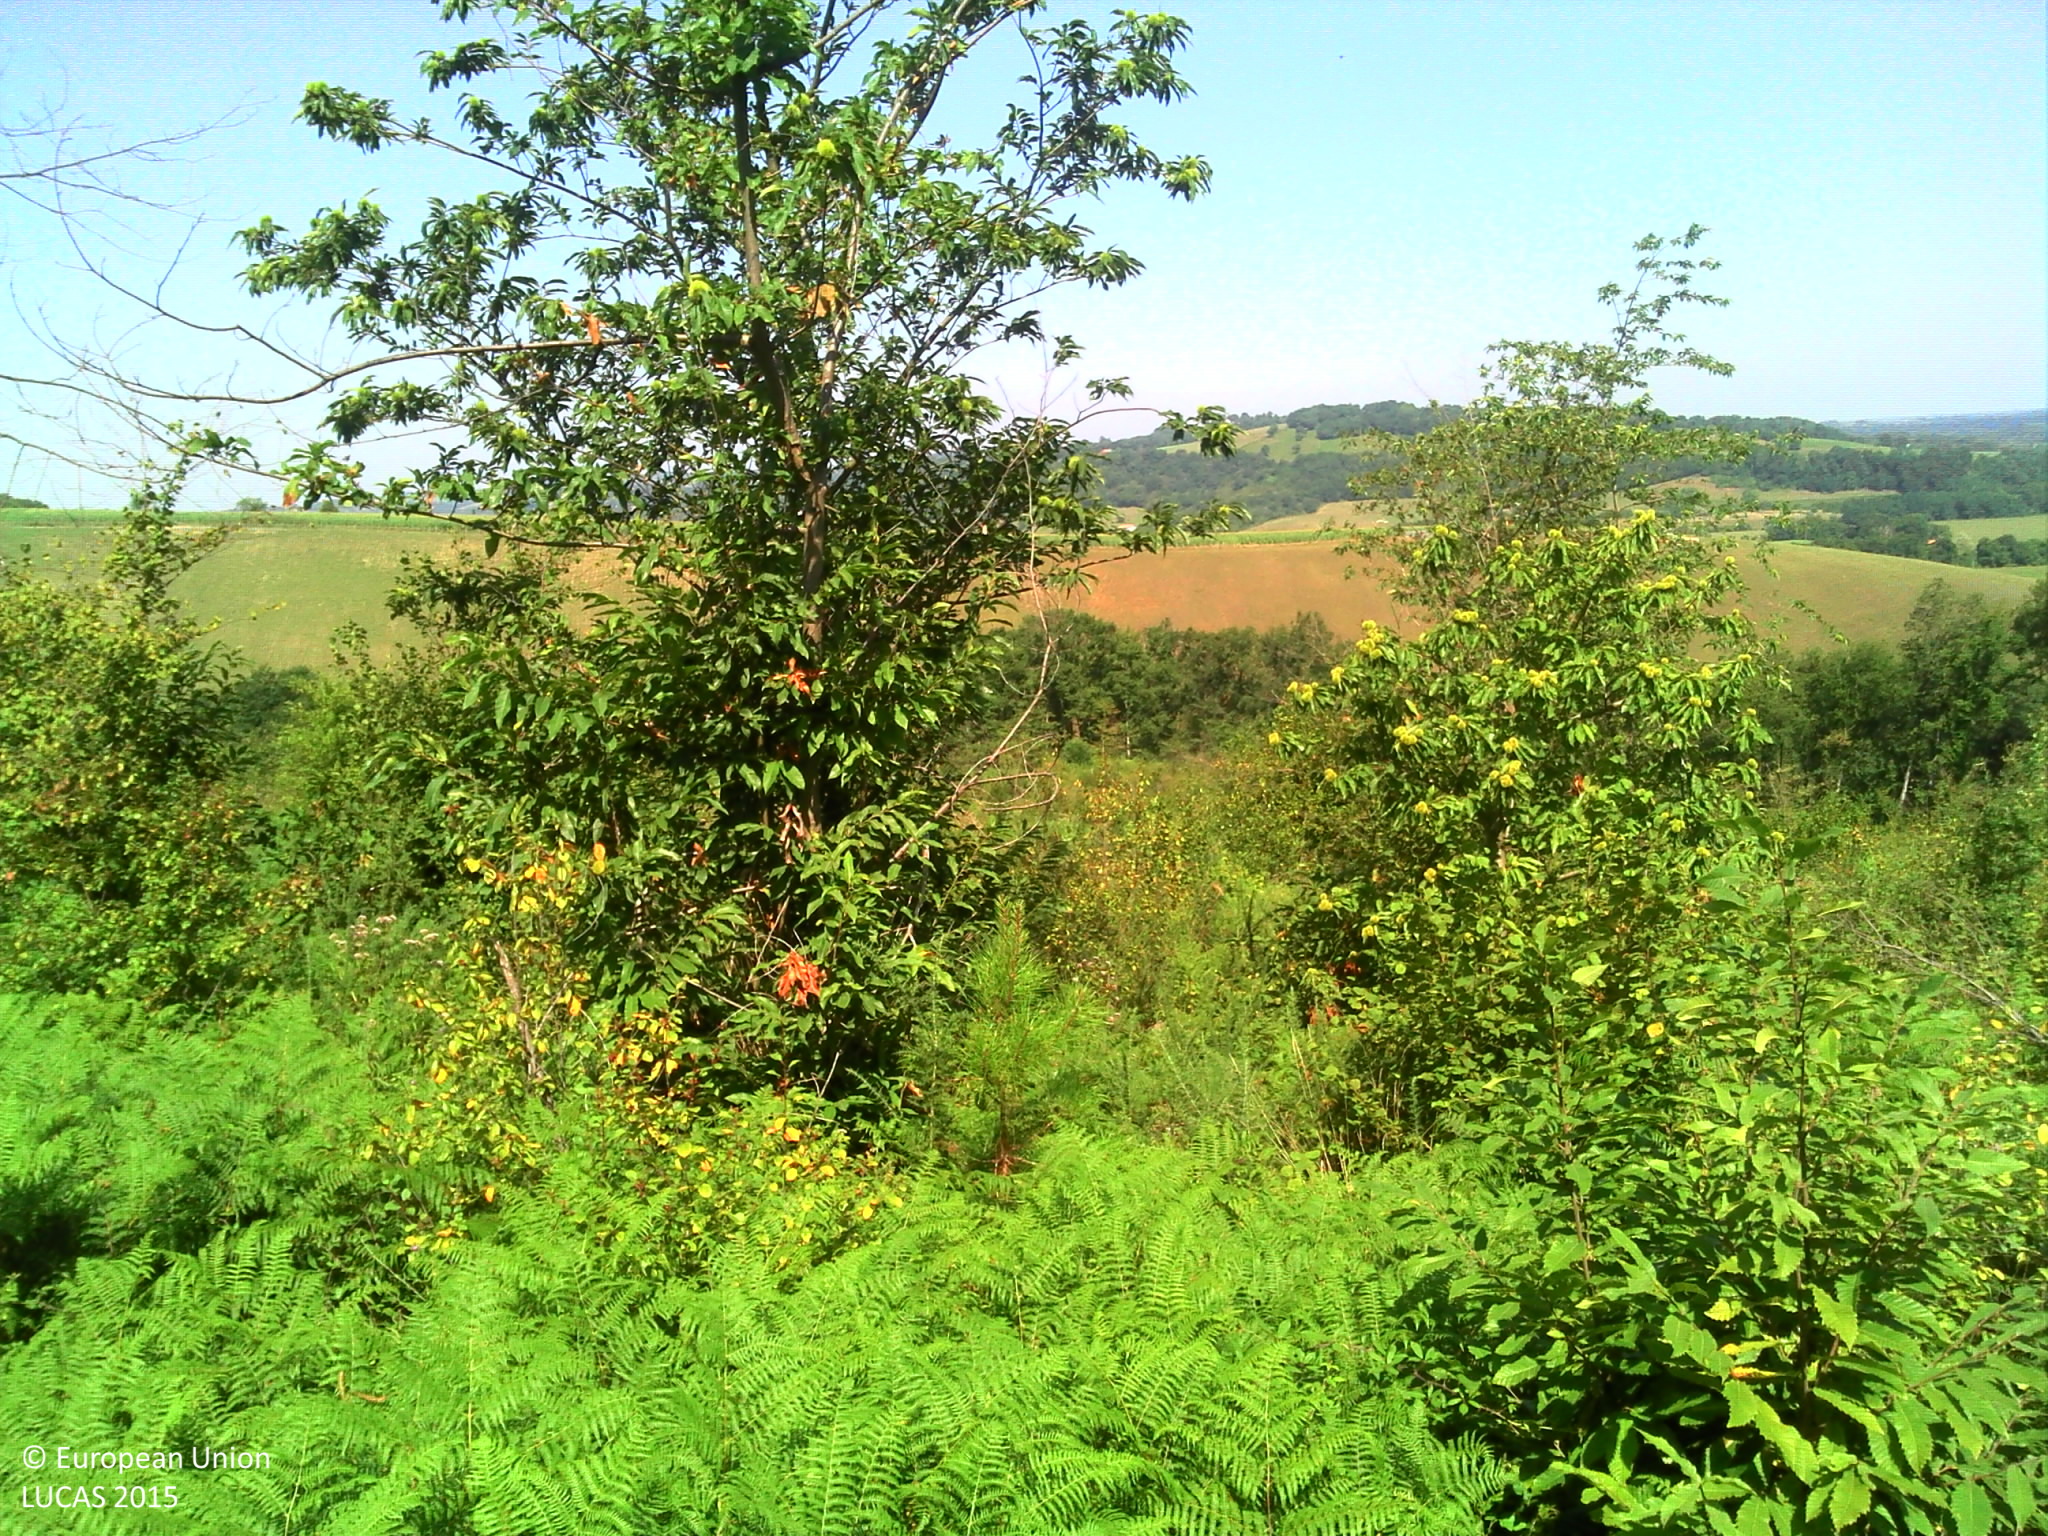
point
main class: Shrubland
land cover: Shrubland with sparse tree cover
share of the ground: > 75 %
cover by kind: herbaceous plants 65 %, shrubs 30 %, broadleaved forest trees 5 %
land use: Forestry
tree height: > 5 m
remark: Clear cut
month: August
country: FR
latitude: 43.4441
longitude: -1.0976
